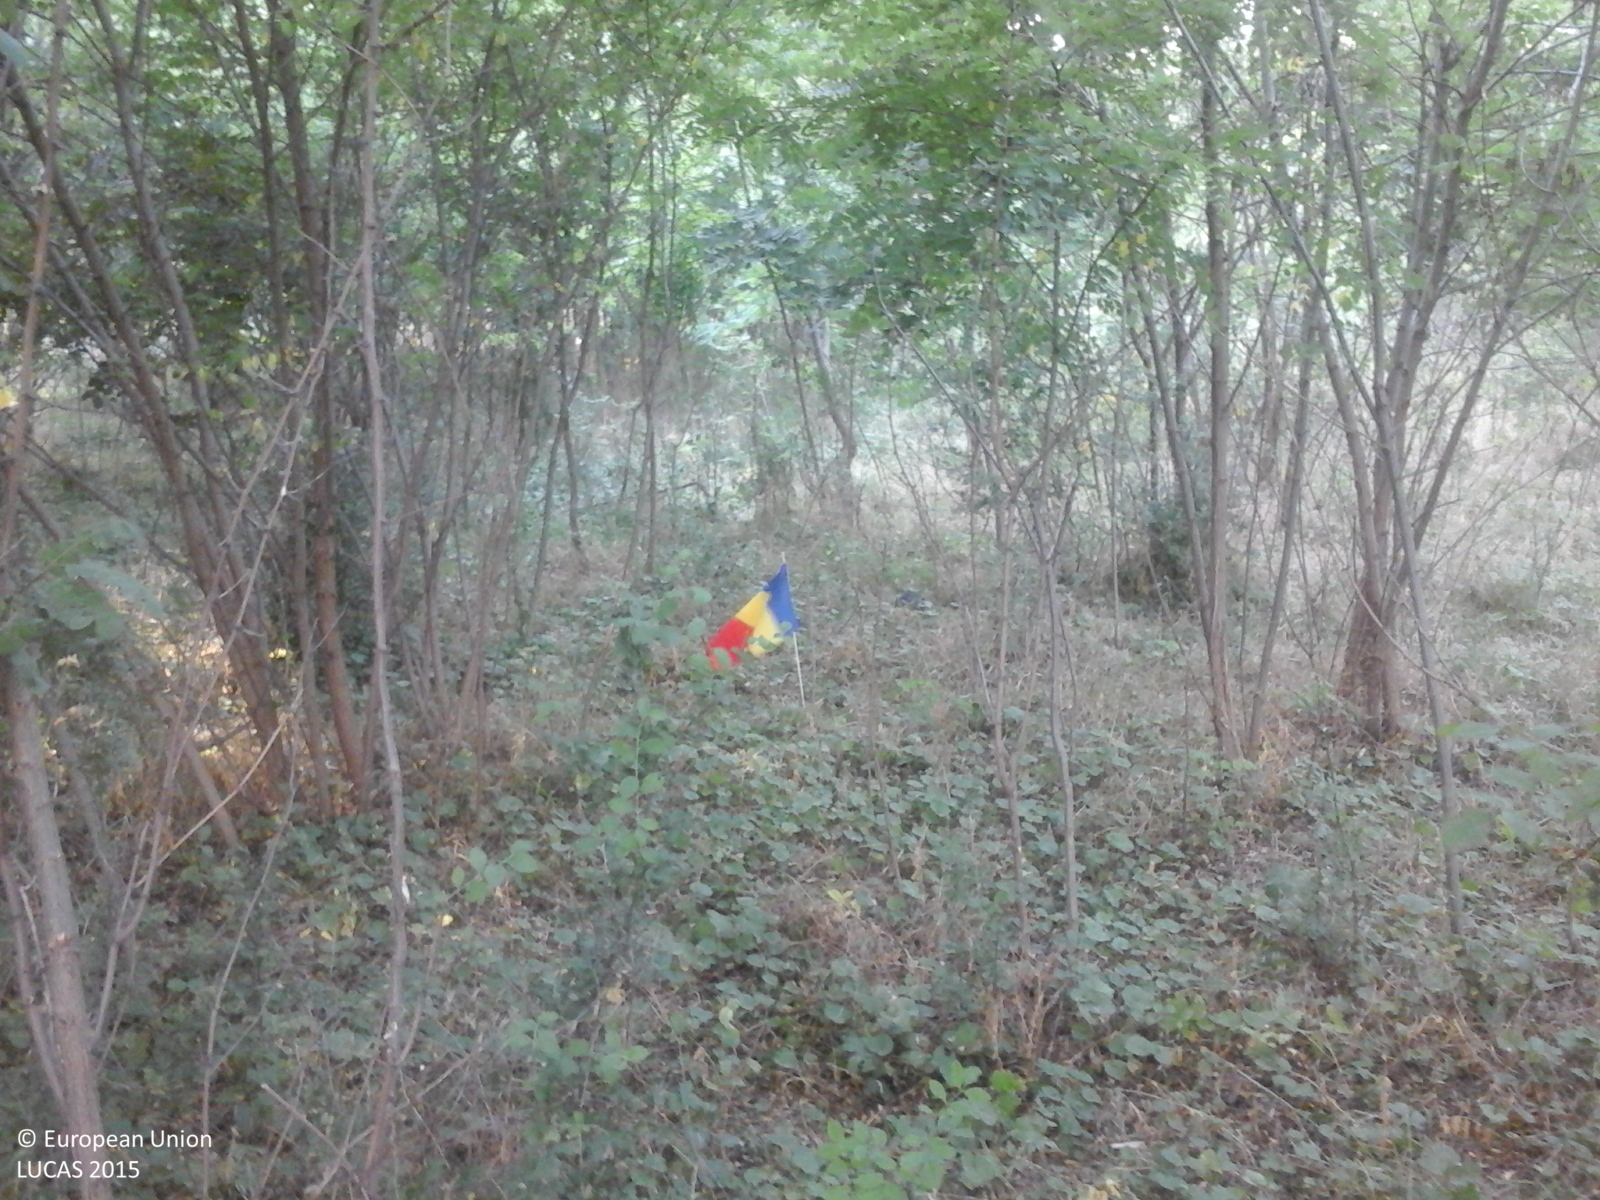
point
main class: Woodland
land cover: Broadleaved woodland
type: exotic forest
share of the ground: > 75 %
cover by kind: broadleaved forest trees 85 %, herbaceous plants 10 %, shrubs 5 %
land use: Forestry
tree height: > 5 m
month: June
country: RO
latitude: 46.7227
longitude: 27.9060
